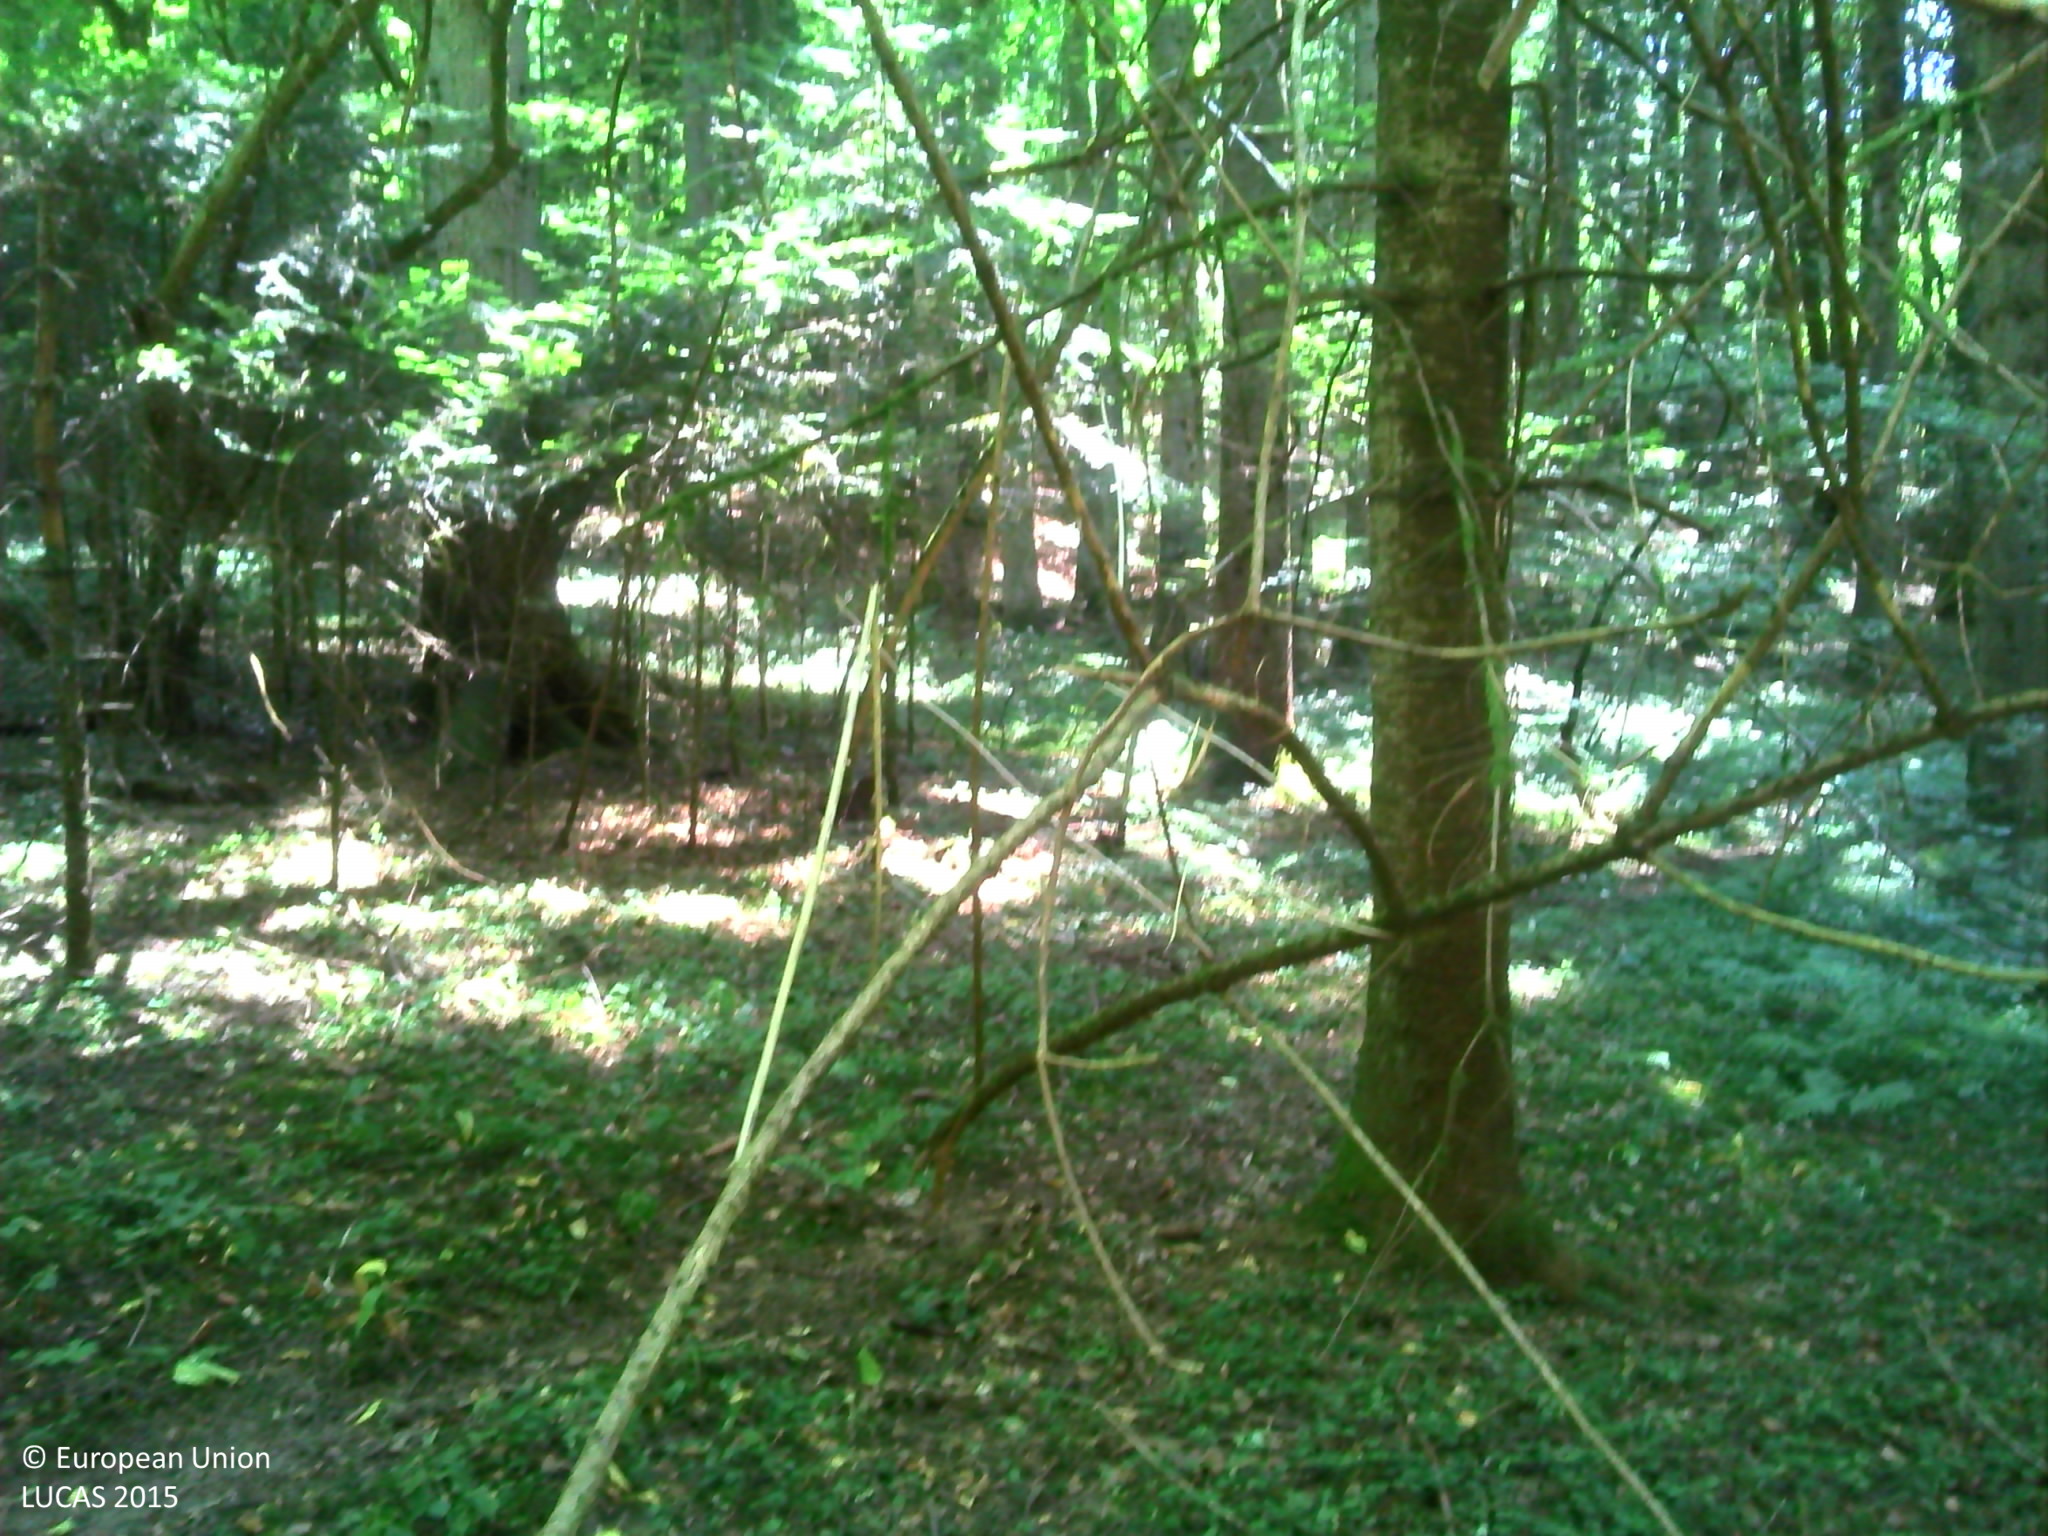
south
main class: Woodland
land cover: Spruce dominated coniferous woodland
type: exotic forest
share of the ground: > 75 %
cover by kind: coniferous forest trees 60 %, broadleaved forest trees 15 %, herbaceous plants 15 %, lichens and mosses 10 %
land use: Forestry
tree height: > 5 m
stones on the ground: < 10 %
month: July
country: FR
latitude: 46.2738
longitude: 6.4348
